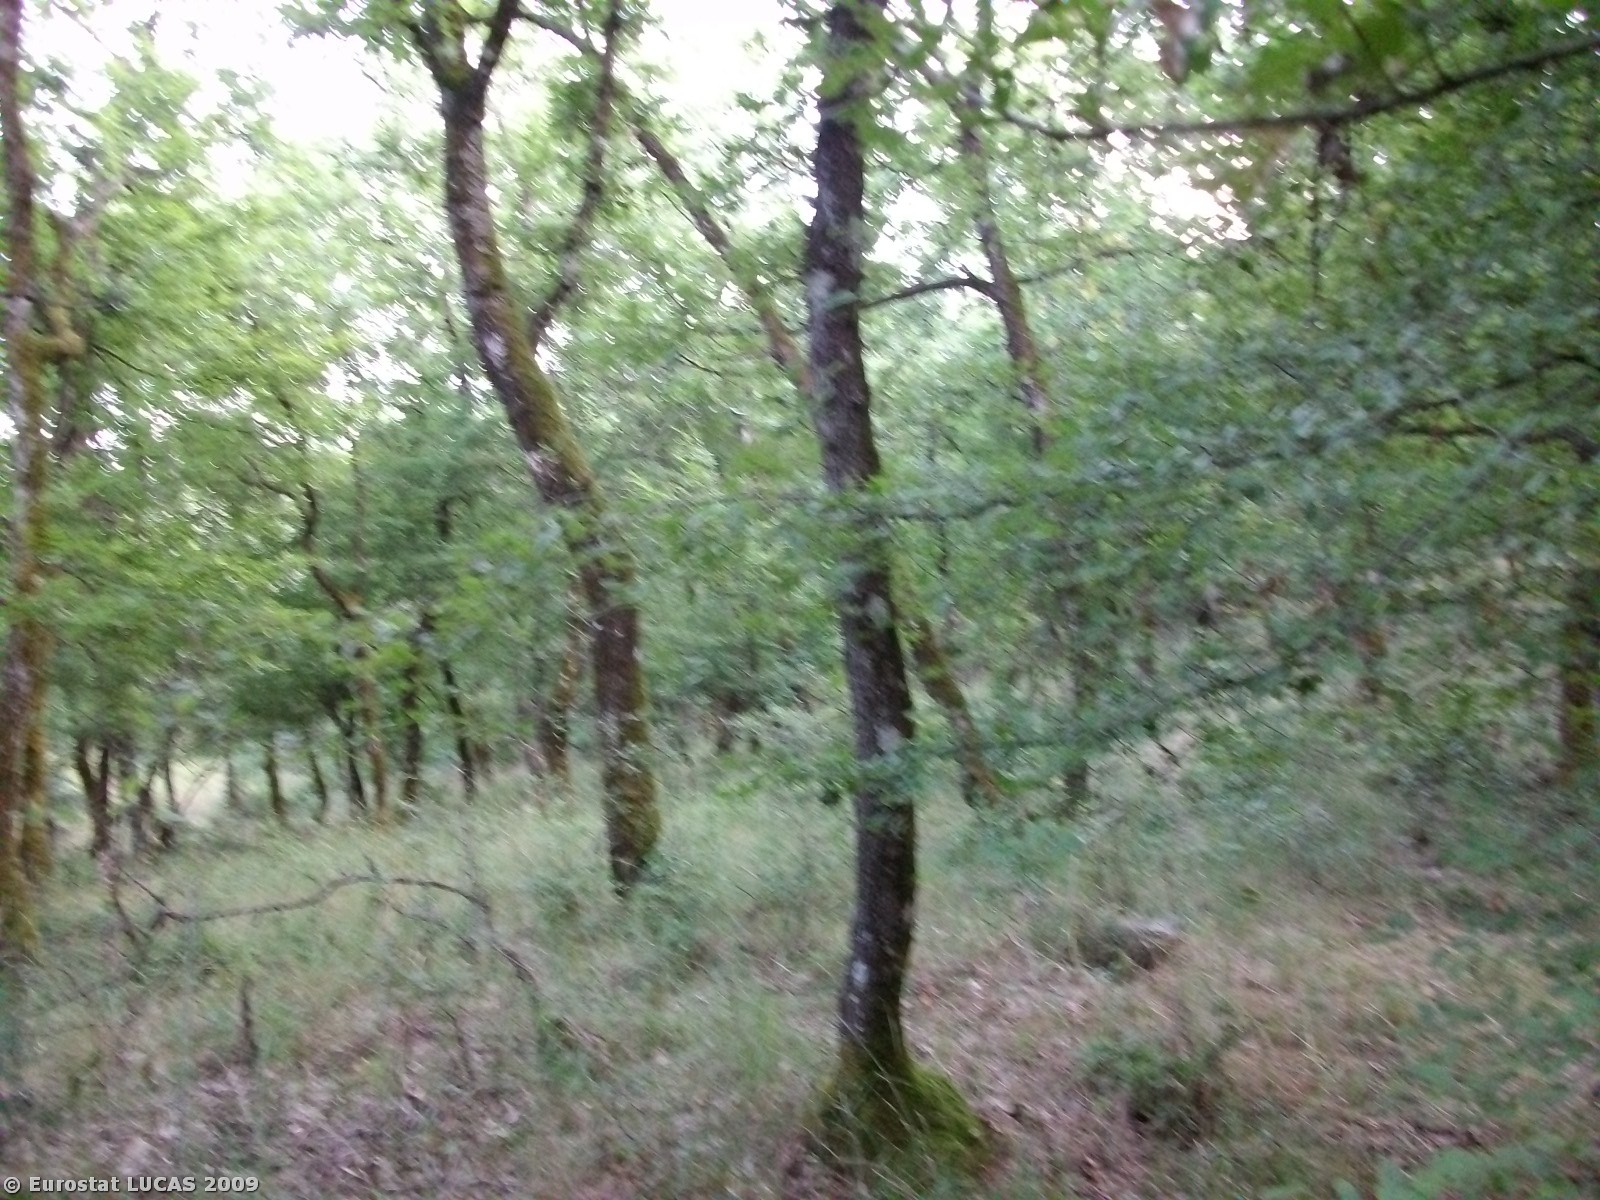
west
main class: Woodland
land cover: Broadleaved woodland
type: broadleaved evergreen forest
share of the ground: > 75 %
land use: Forestry
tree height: > 5 m
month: July
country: GR
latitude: 39.5395
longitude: 21.6059
